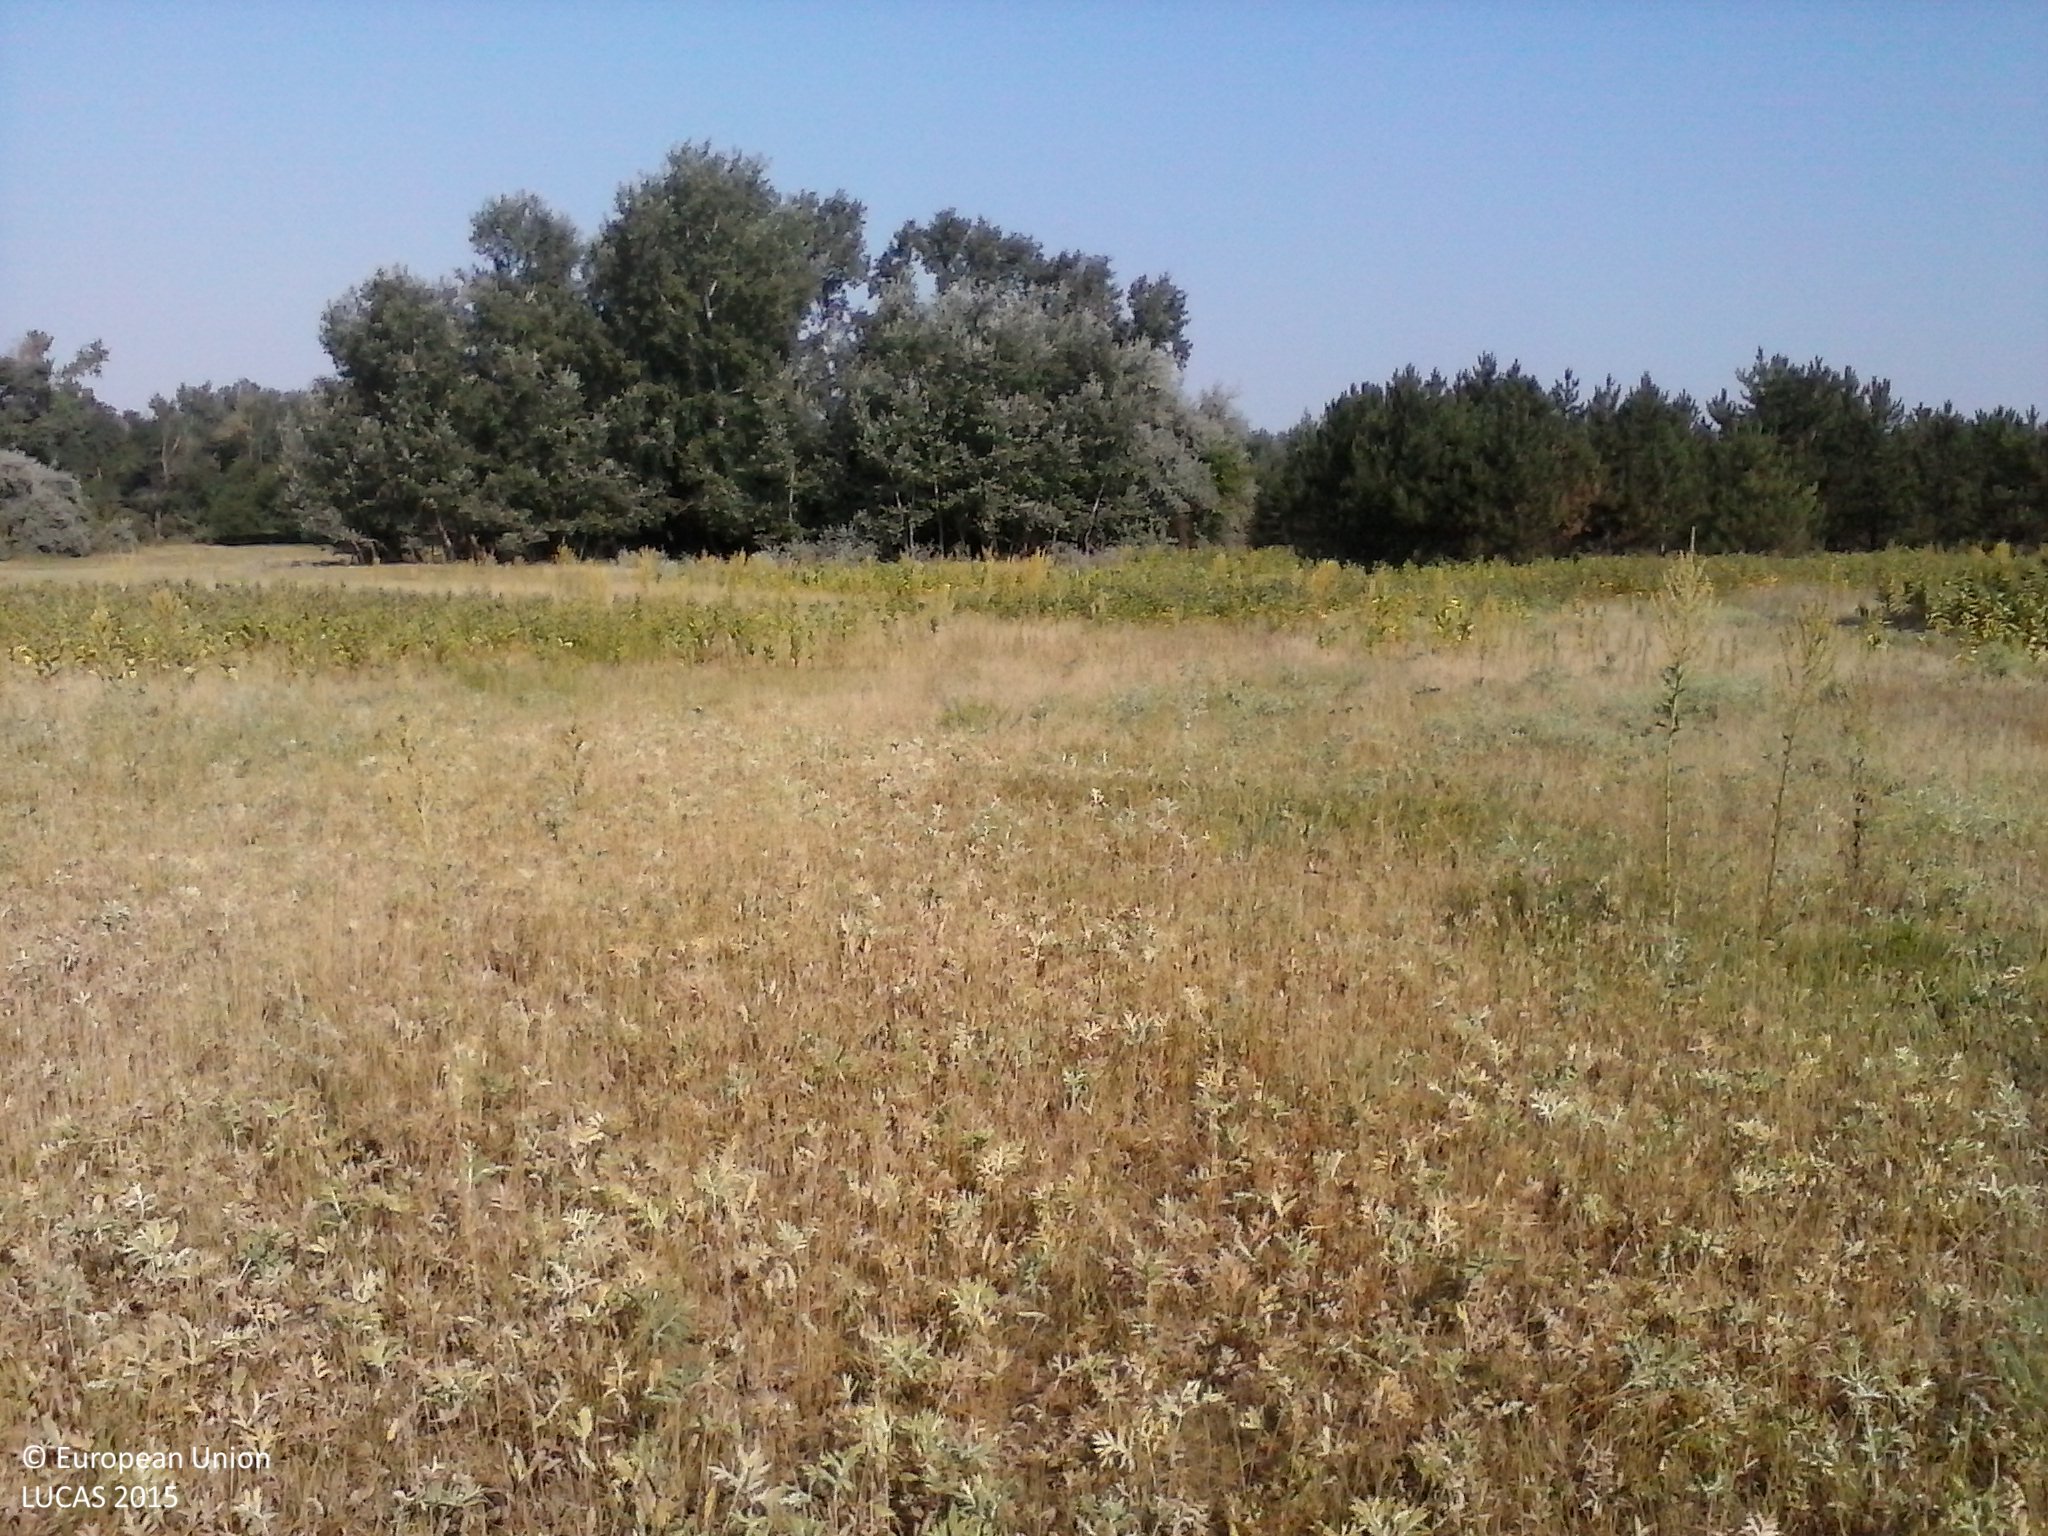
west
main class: Grassland
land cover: Spontaneously vegetated surfaces
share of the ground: > 75 %
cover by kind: herbaceous plants 100 %
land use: Agriculture (excluding fallow land and kitchen gardens)
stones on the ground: < 10 %
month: July
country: HU
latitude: 46.4363
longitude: 19.6889
